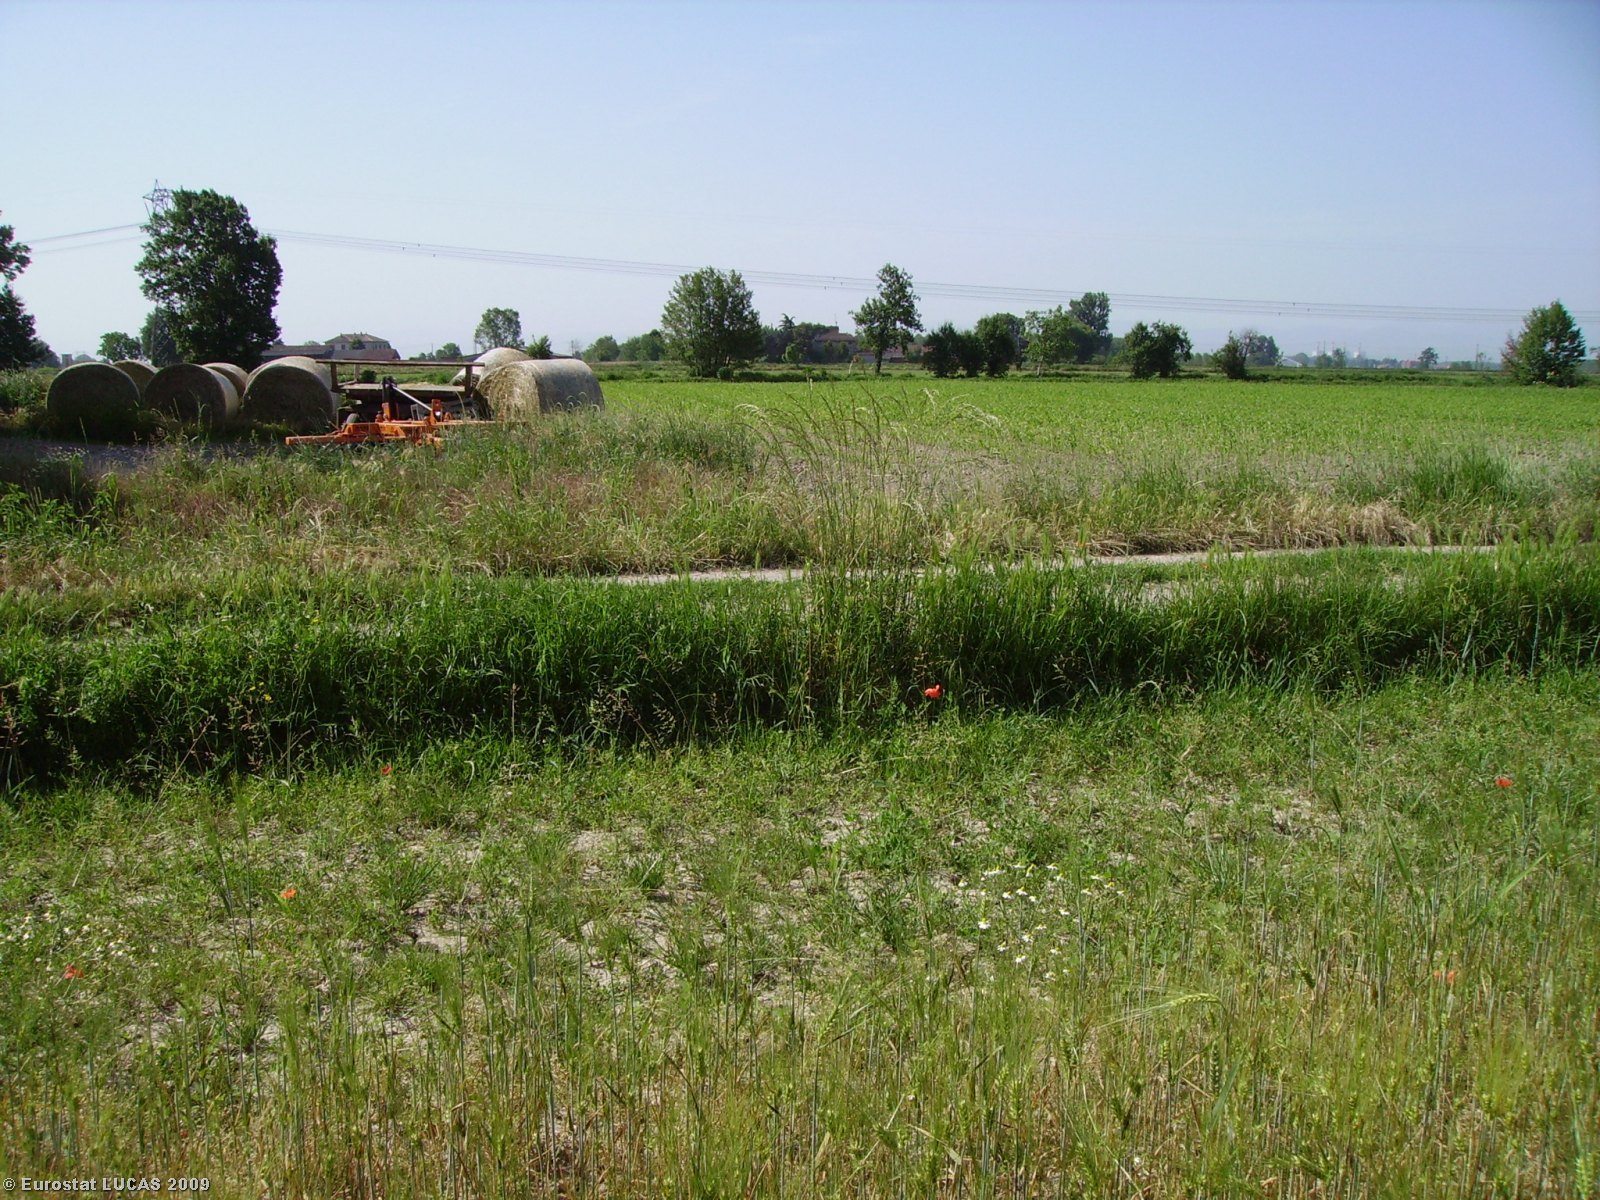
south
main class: Cropland
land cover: Common wheat
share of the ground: 50 - 75 %
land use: Agriculture (excluding fallow land and kitchen gardens)
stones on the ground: < 10 %
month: May
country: IT
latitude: 45.1427
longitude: 9.5050
